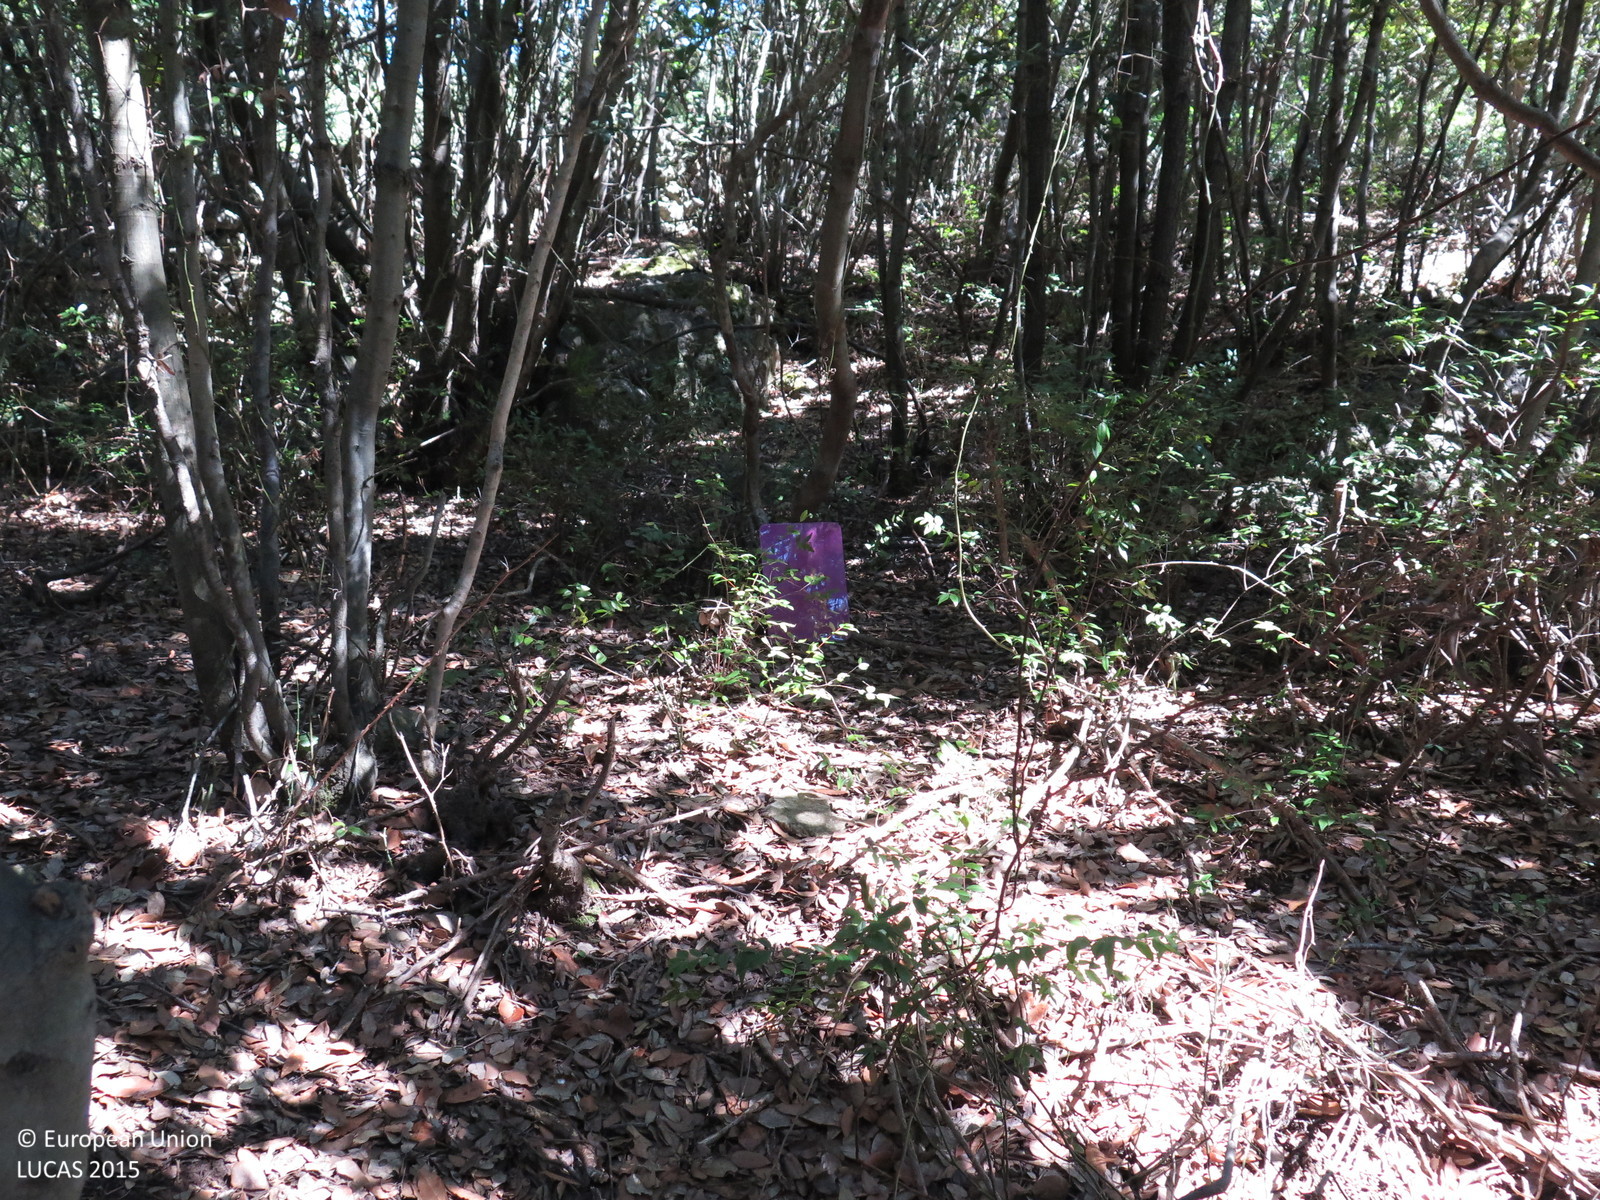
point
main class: Woodland
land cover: Broadleaved woodland
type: thermophilous deciduous forest
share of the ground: > 75 %
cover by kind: broadleaved forest trees 90 %, shrubs 5 %, herbaceous plants 5 %
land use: Semi-natural and natural areas not in use
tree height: < 5 m
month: September
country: HR
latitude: 44.6325
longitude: 14.4935
